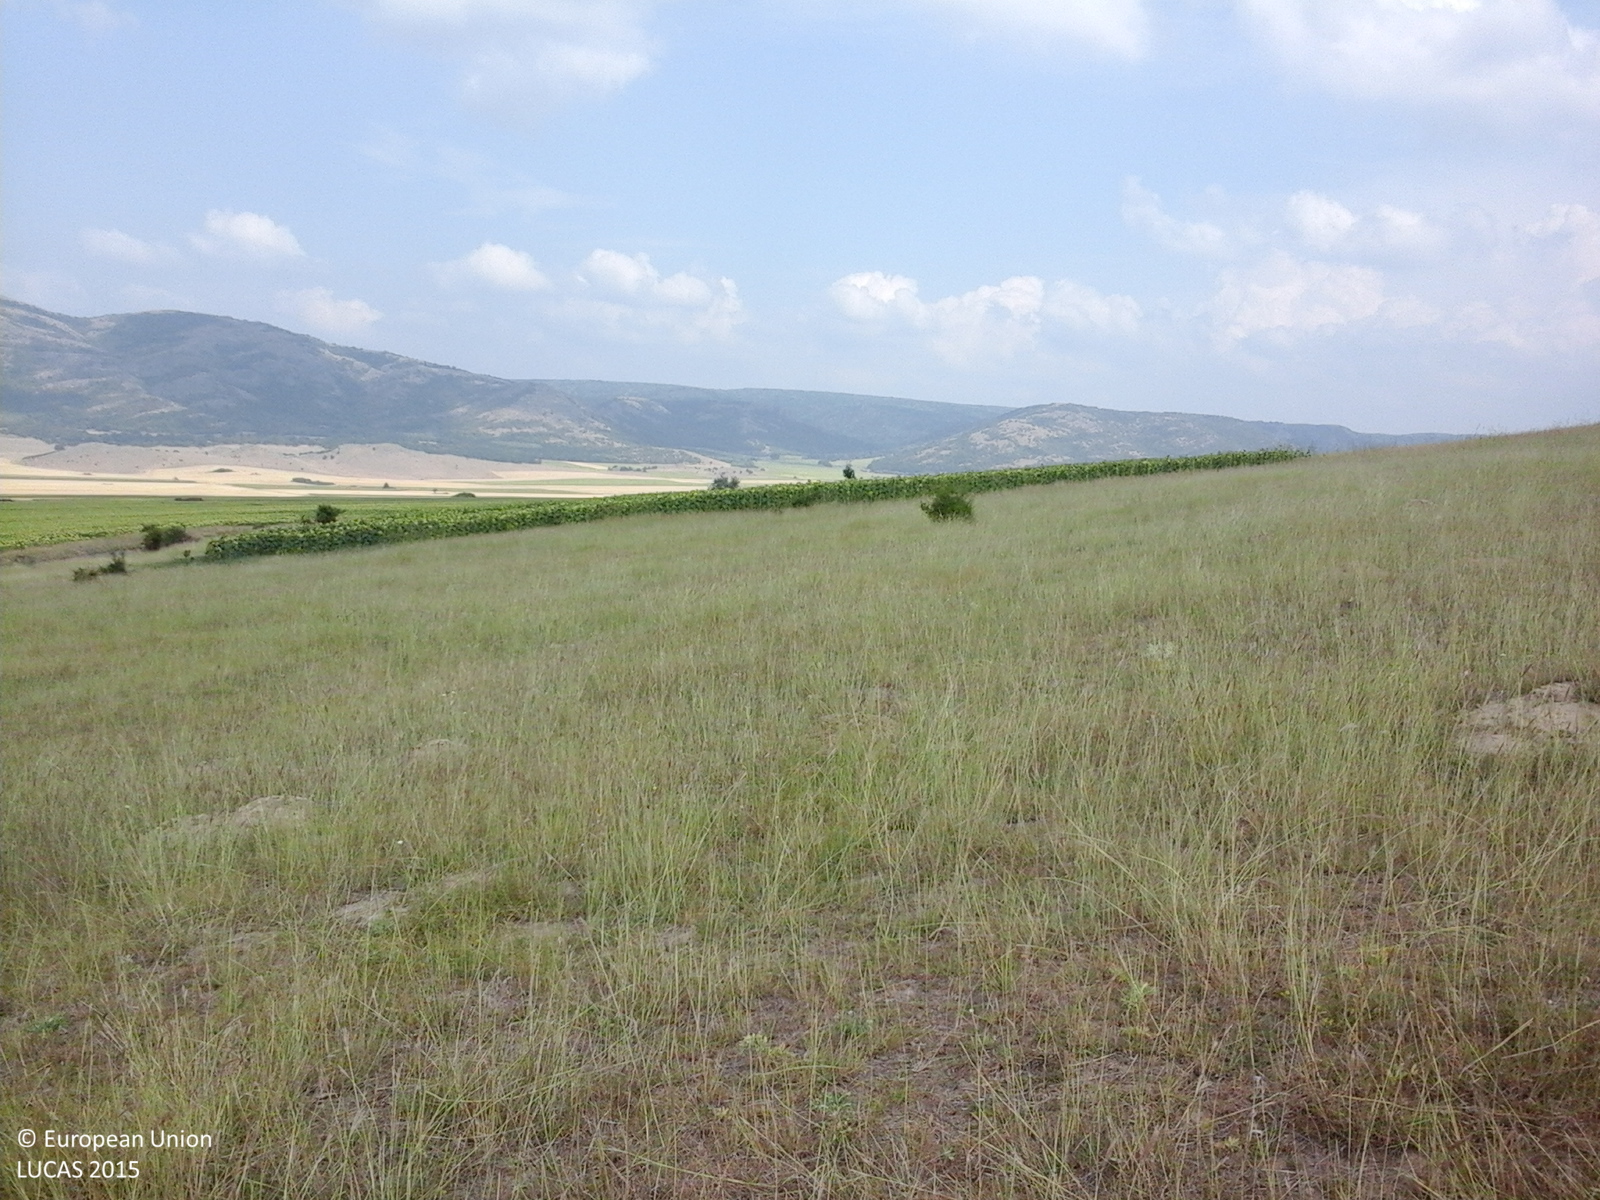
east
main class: Grassland
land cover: Grassland without tree/shrub cover
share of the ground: > 75 %
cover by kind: herbaceous plants 100 %
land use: Agriculture (excluding fallow land and kitchen gardens)
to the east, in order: Grassland without tree/shrub cover; Sunflower
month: July
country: RO
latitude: 45.1516
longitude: 28.2474
